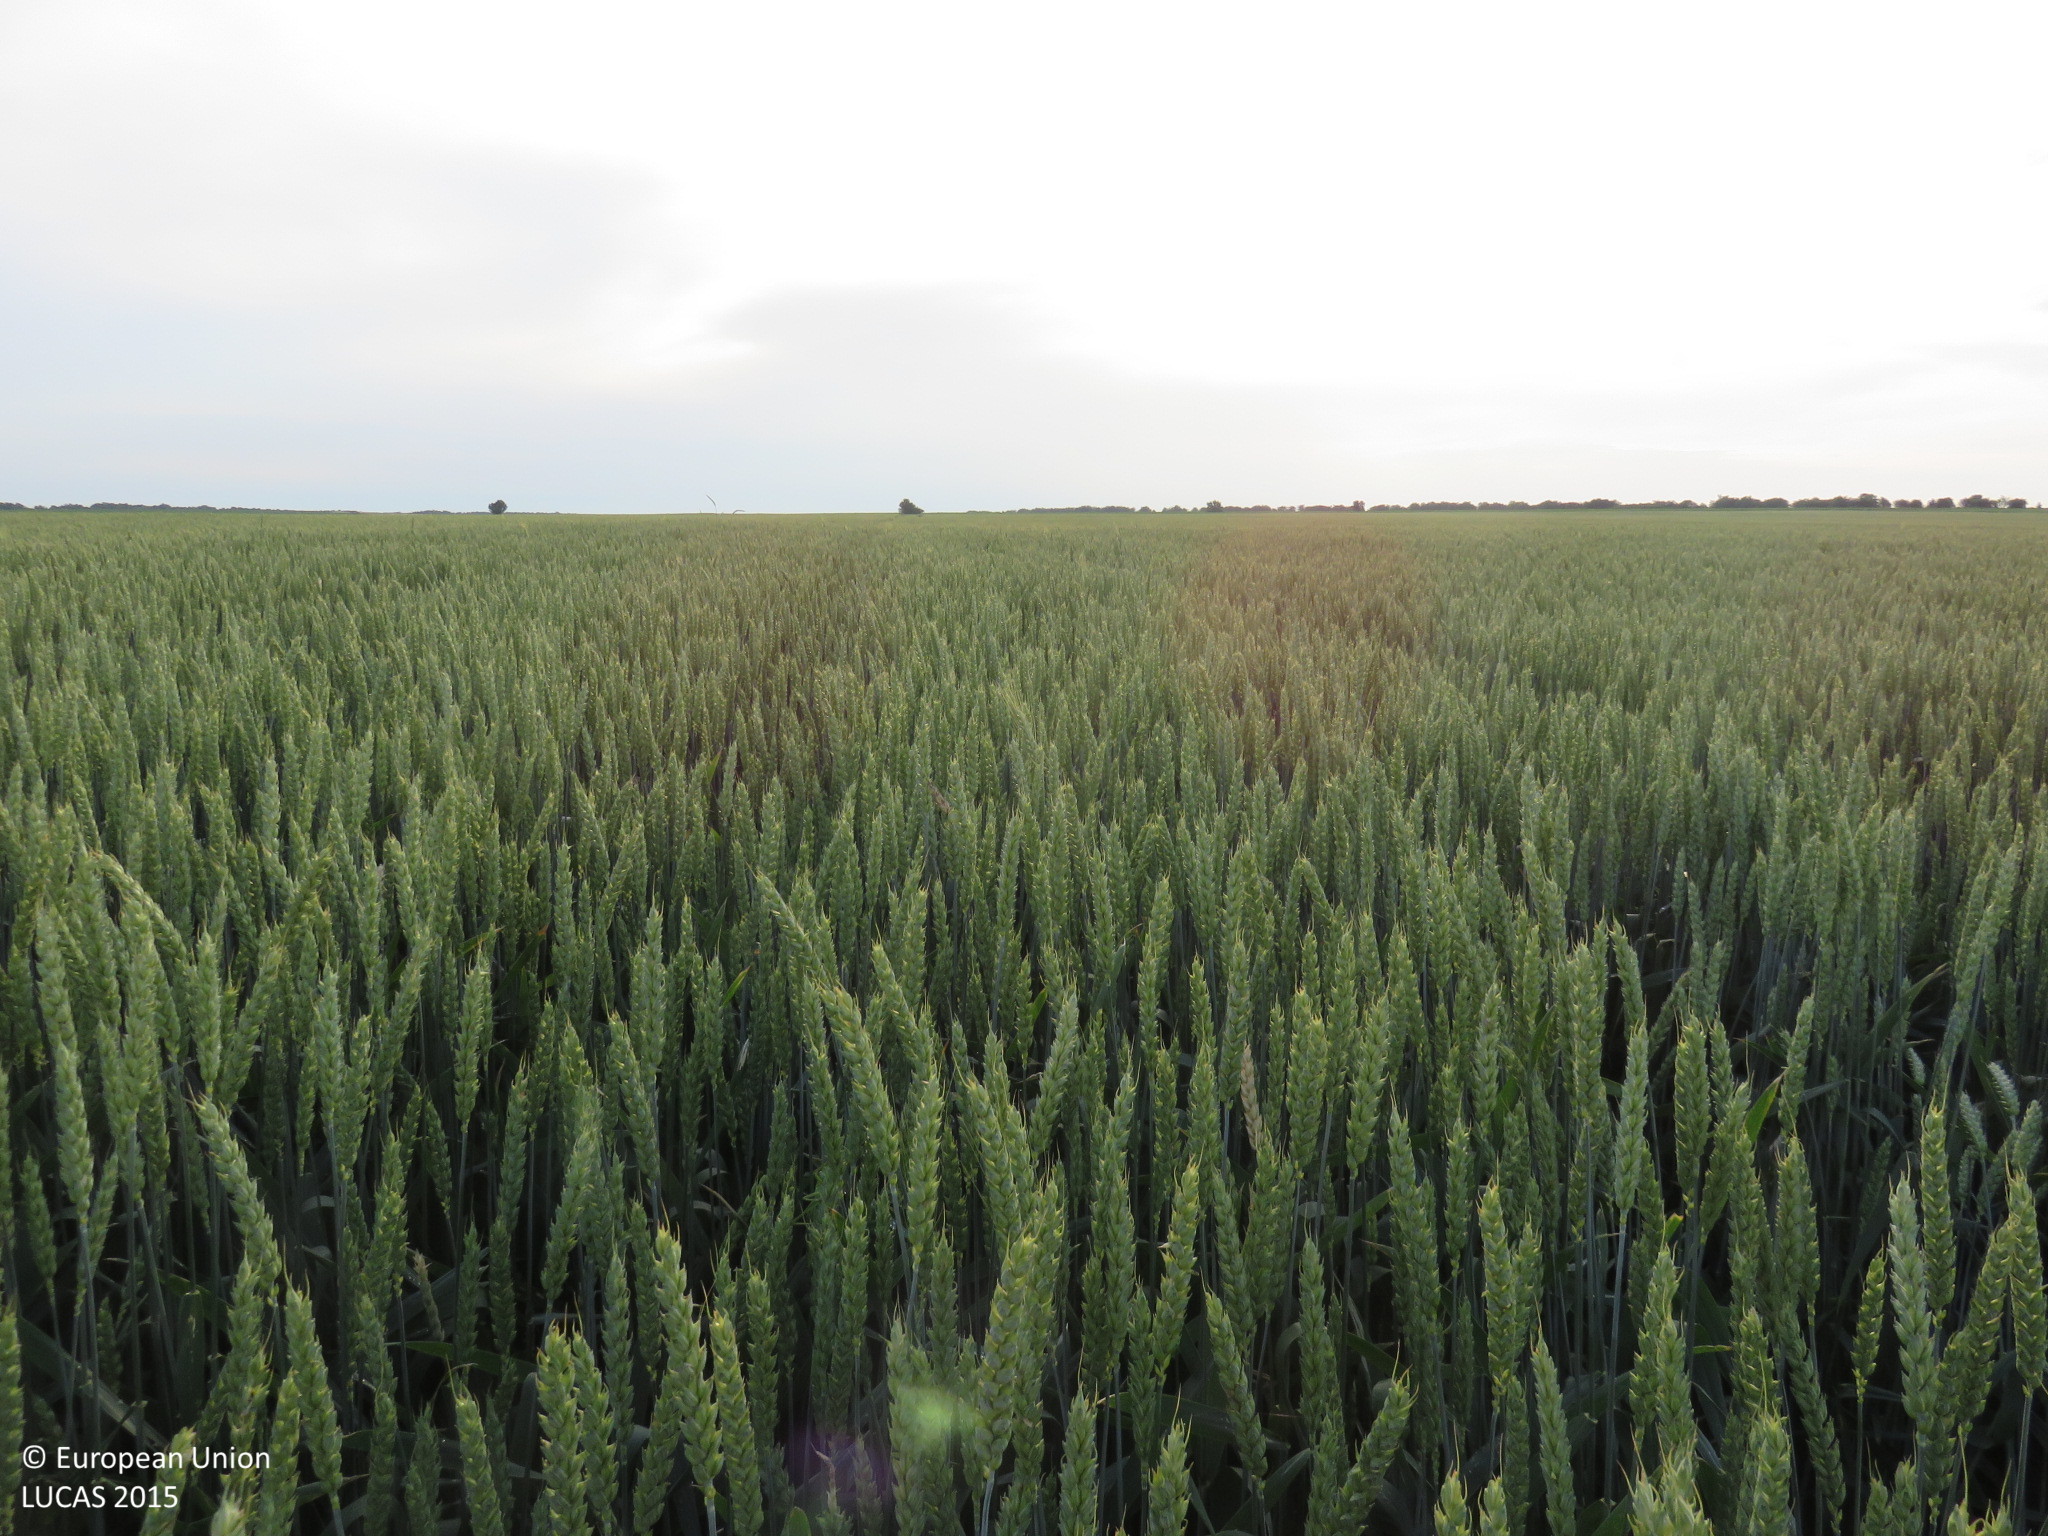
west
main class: Cropland
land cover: Common wheat
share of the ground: > 75 %
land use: Agriculture (excluding fallow land and kitchen gardens)
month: June
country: BG
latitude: 43.4351
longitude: 24.5032
